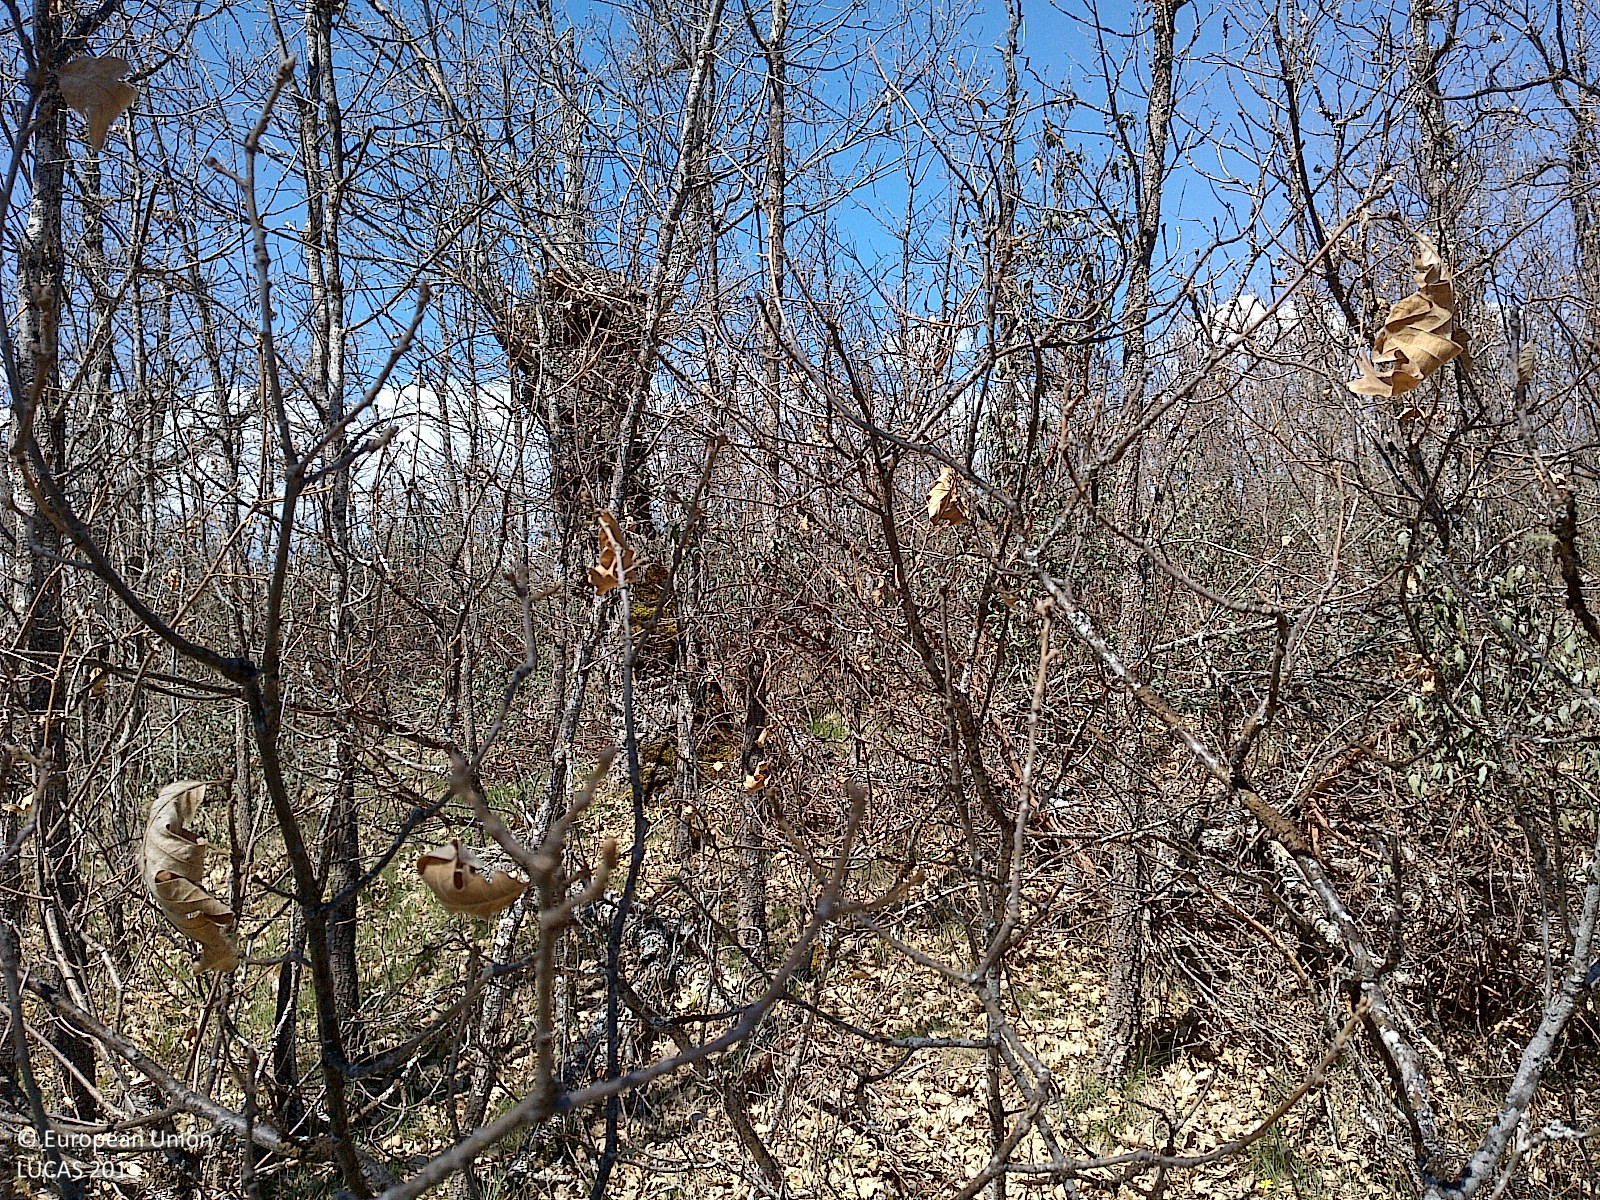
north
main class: Woodland
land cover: Broadleaved woodland
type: thermophilous deciduous forest
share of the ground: > 75 %
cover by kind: broadleaved forest trees 80 %, herbaceous plants 15 %, shrubs 5 %
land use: Forestry
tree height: > 5 m
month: April
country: ES
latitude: 42.1025
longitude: -3.2930
